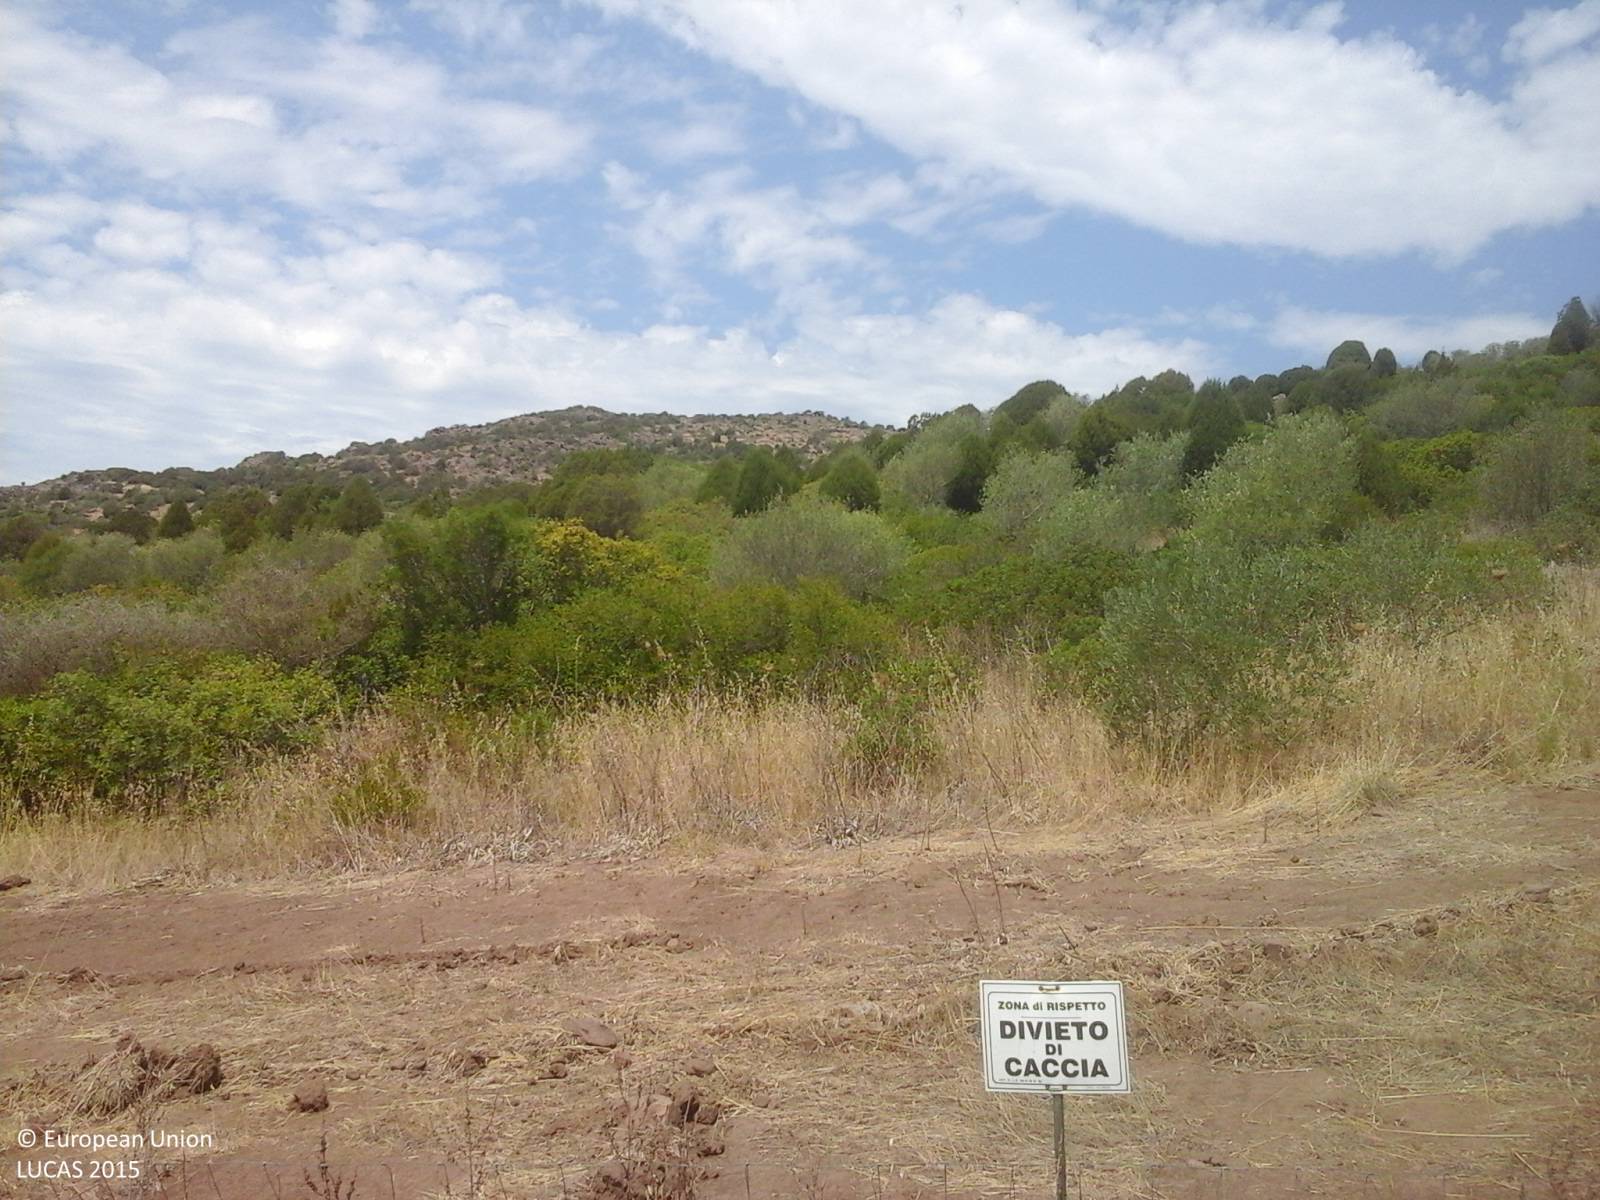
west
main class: Shrubland
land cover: Shrubland with sparse tree cover
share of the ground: > 75 %
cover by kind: shrubs 70 %, unconsolidated bare surface 20 %, broadleaved forest trees 5 %, herbaceous plants 5 %
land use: Agriculture (excluding fallow land and kitchen gardens)
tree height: < 5 m
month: July
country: IT
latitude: 39.1165
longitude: 8.6323
